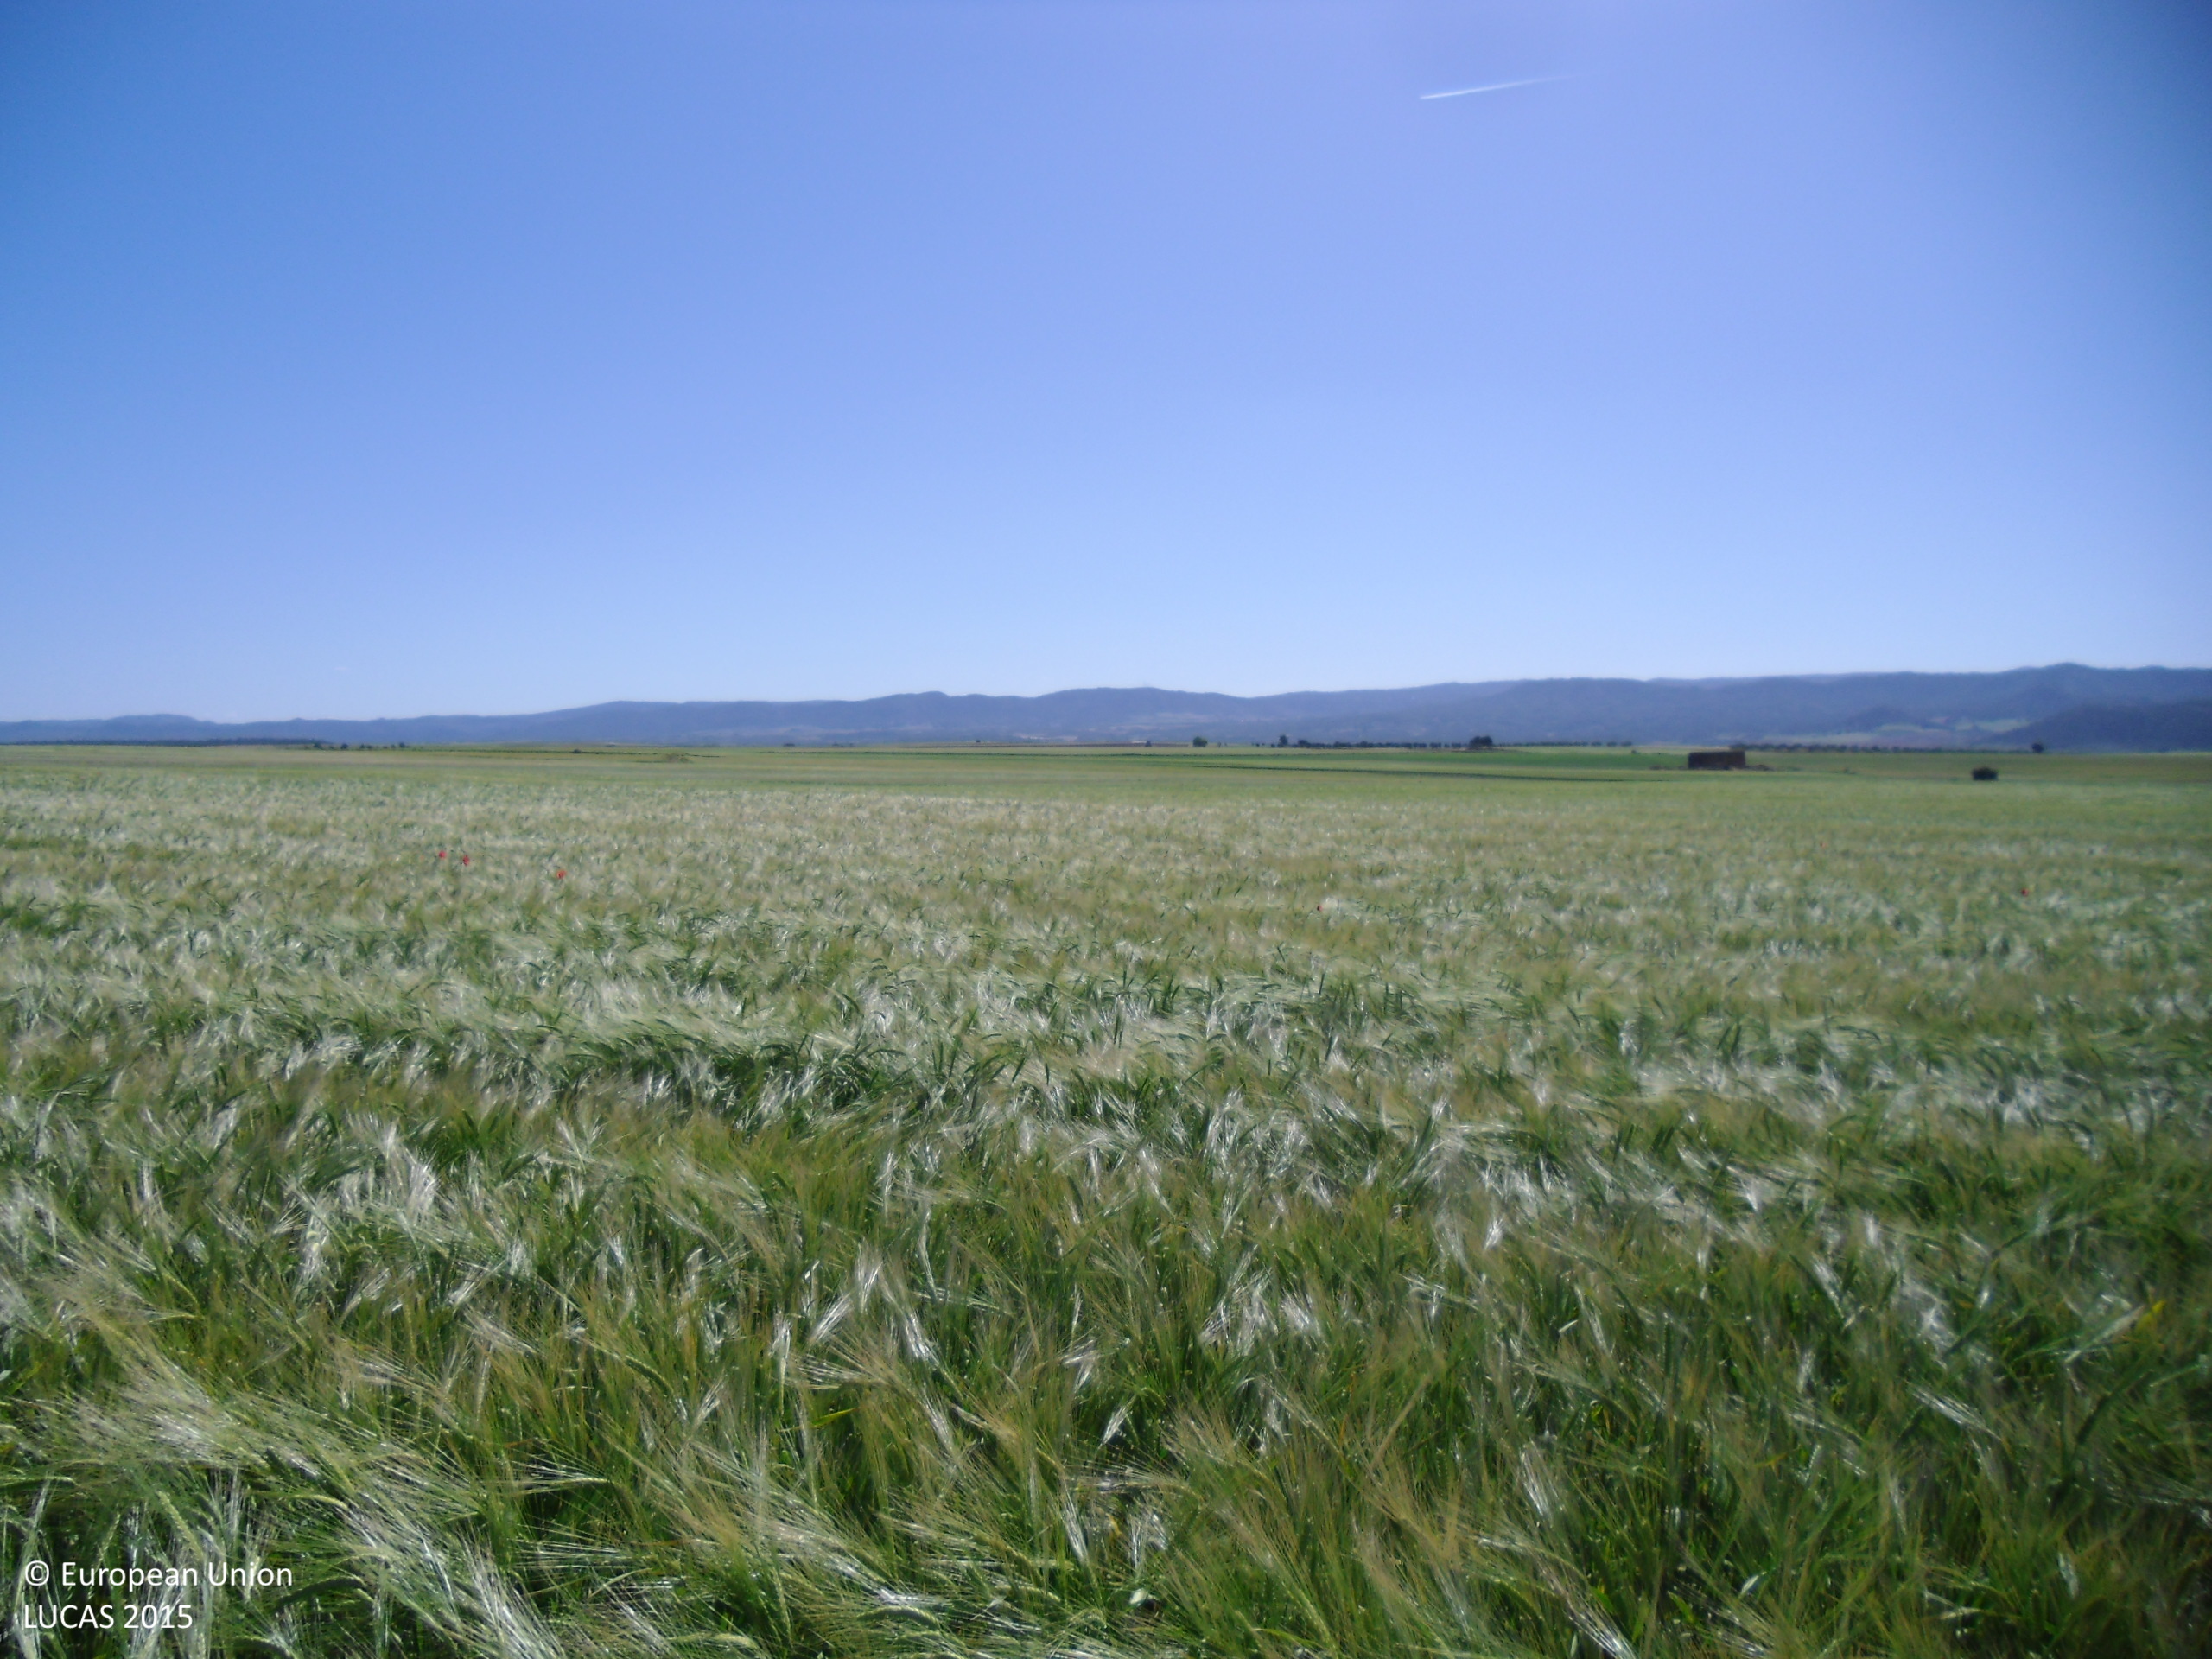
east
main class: Cropland
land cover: Barley
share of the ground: > 75 %
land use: Agriculture (excluding fallow land and kitchen gardens)
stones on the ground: < 10 %
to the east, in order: Barley; Tracks; Barley
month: May
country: ES
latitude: 40.3007
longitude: -2.9566
